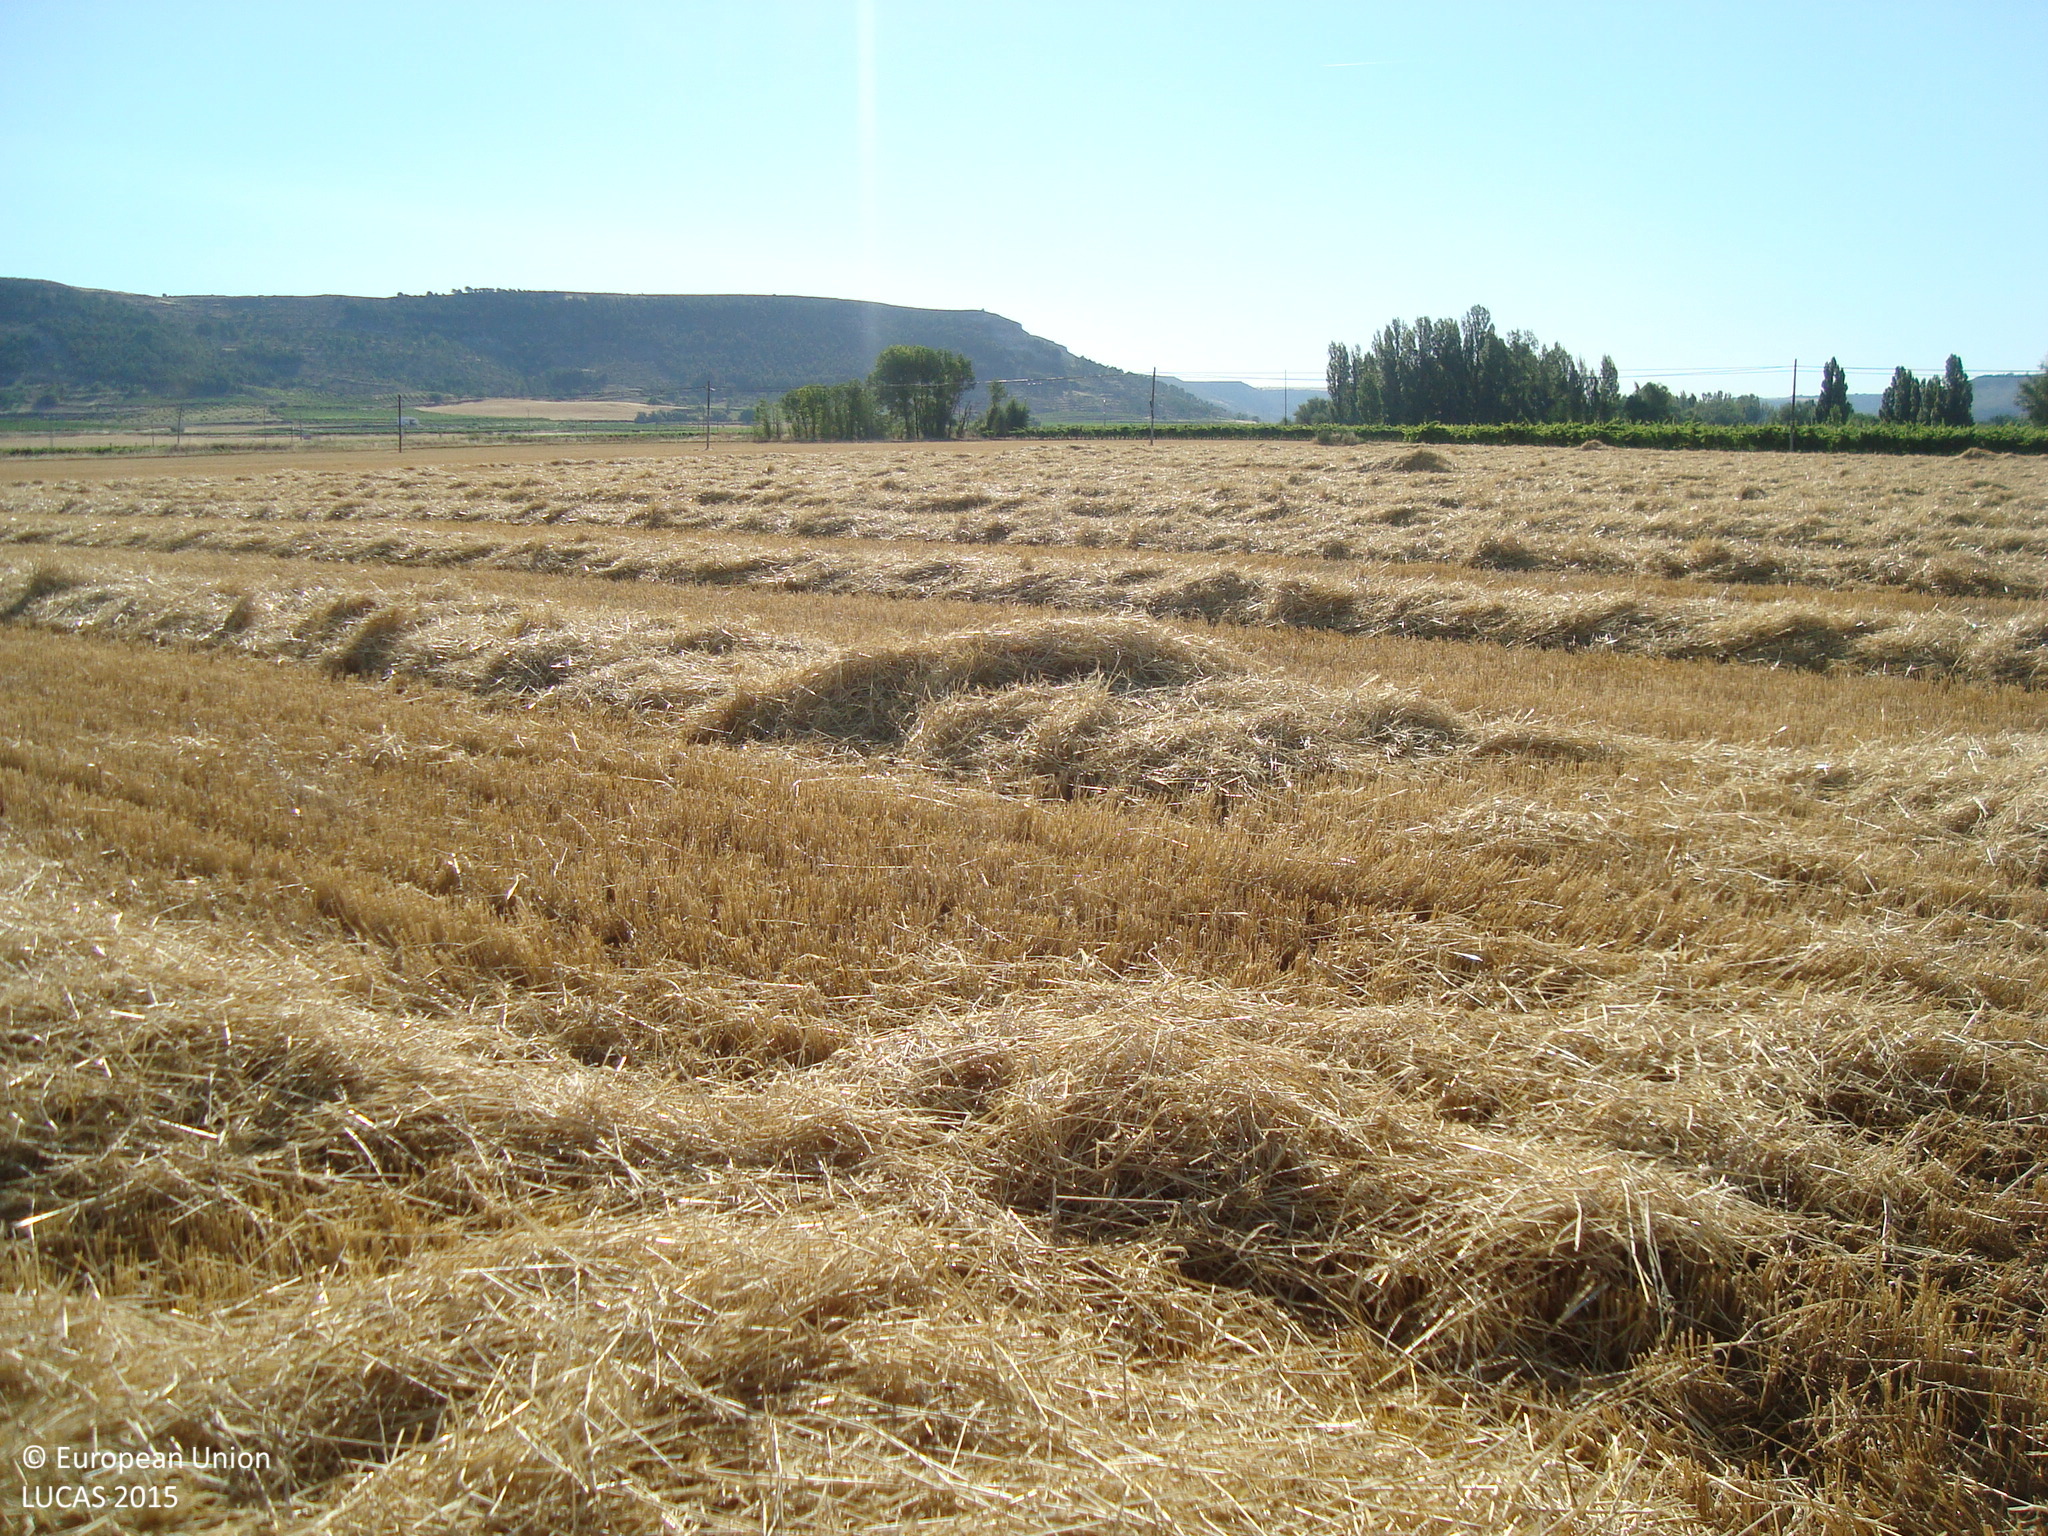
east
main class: Cropland
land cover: Barley
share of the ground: < 10 %
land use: Agriculture (excluding fallow land and kitchen gardens)
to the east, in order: Barley; Electric lines; Vineyards
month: July
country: ES
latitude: 41.6236
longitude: -4.1133
